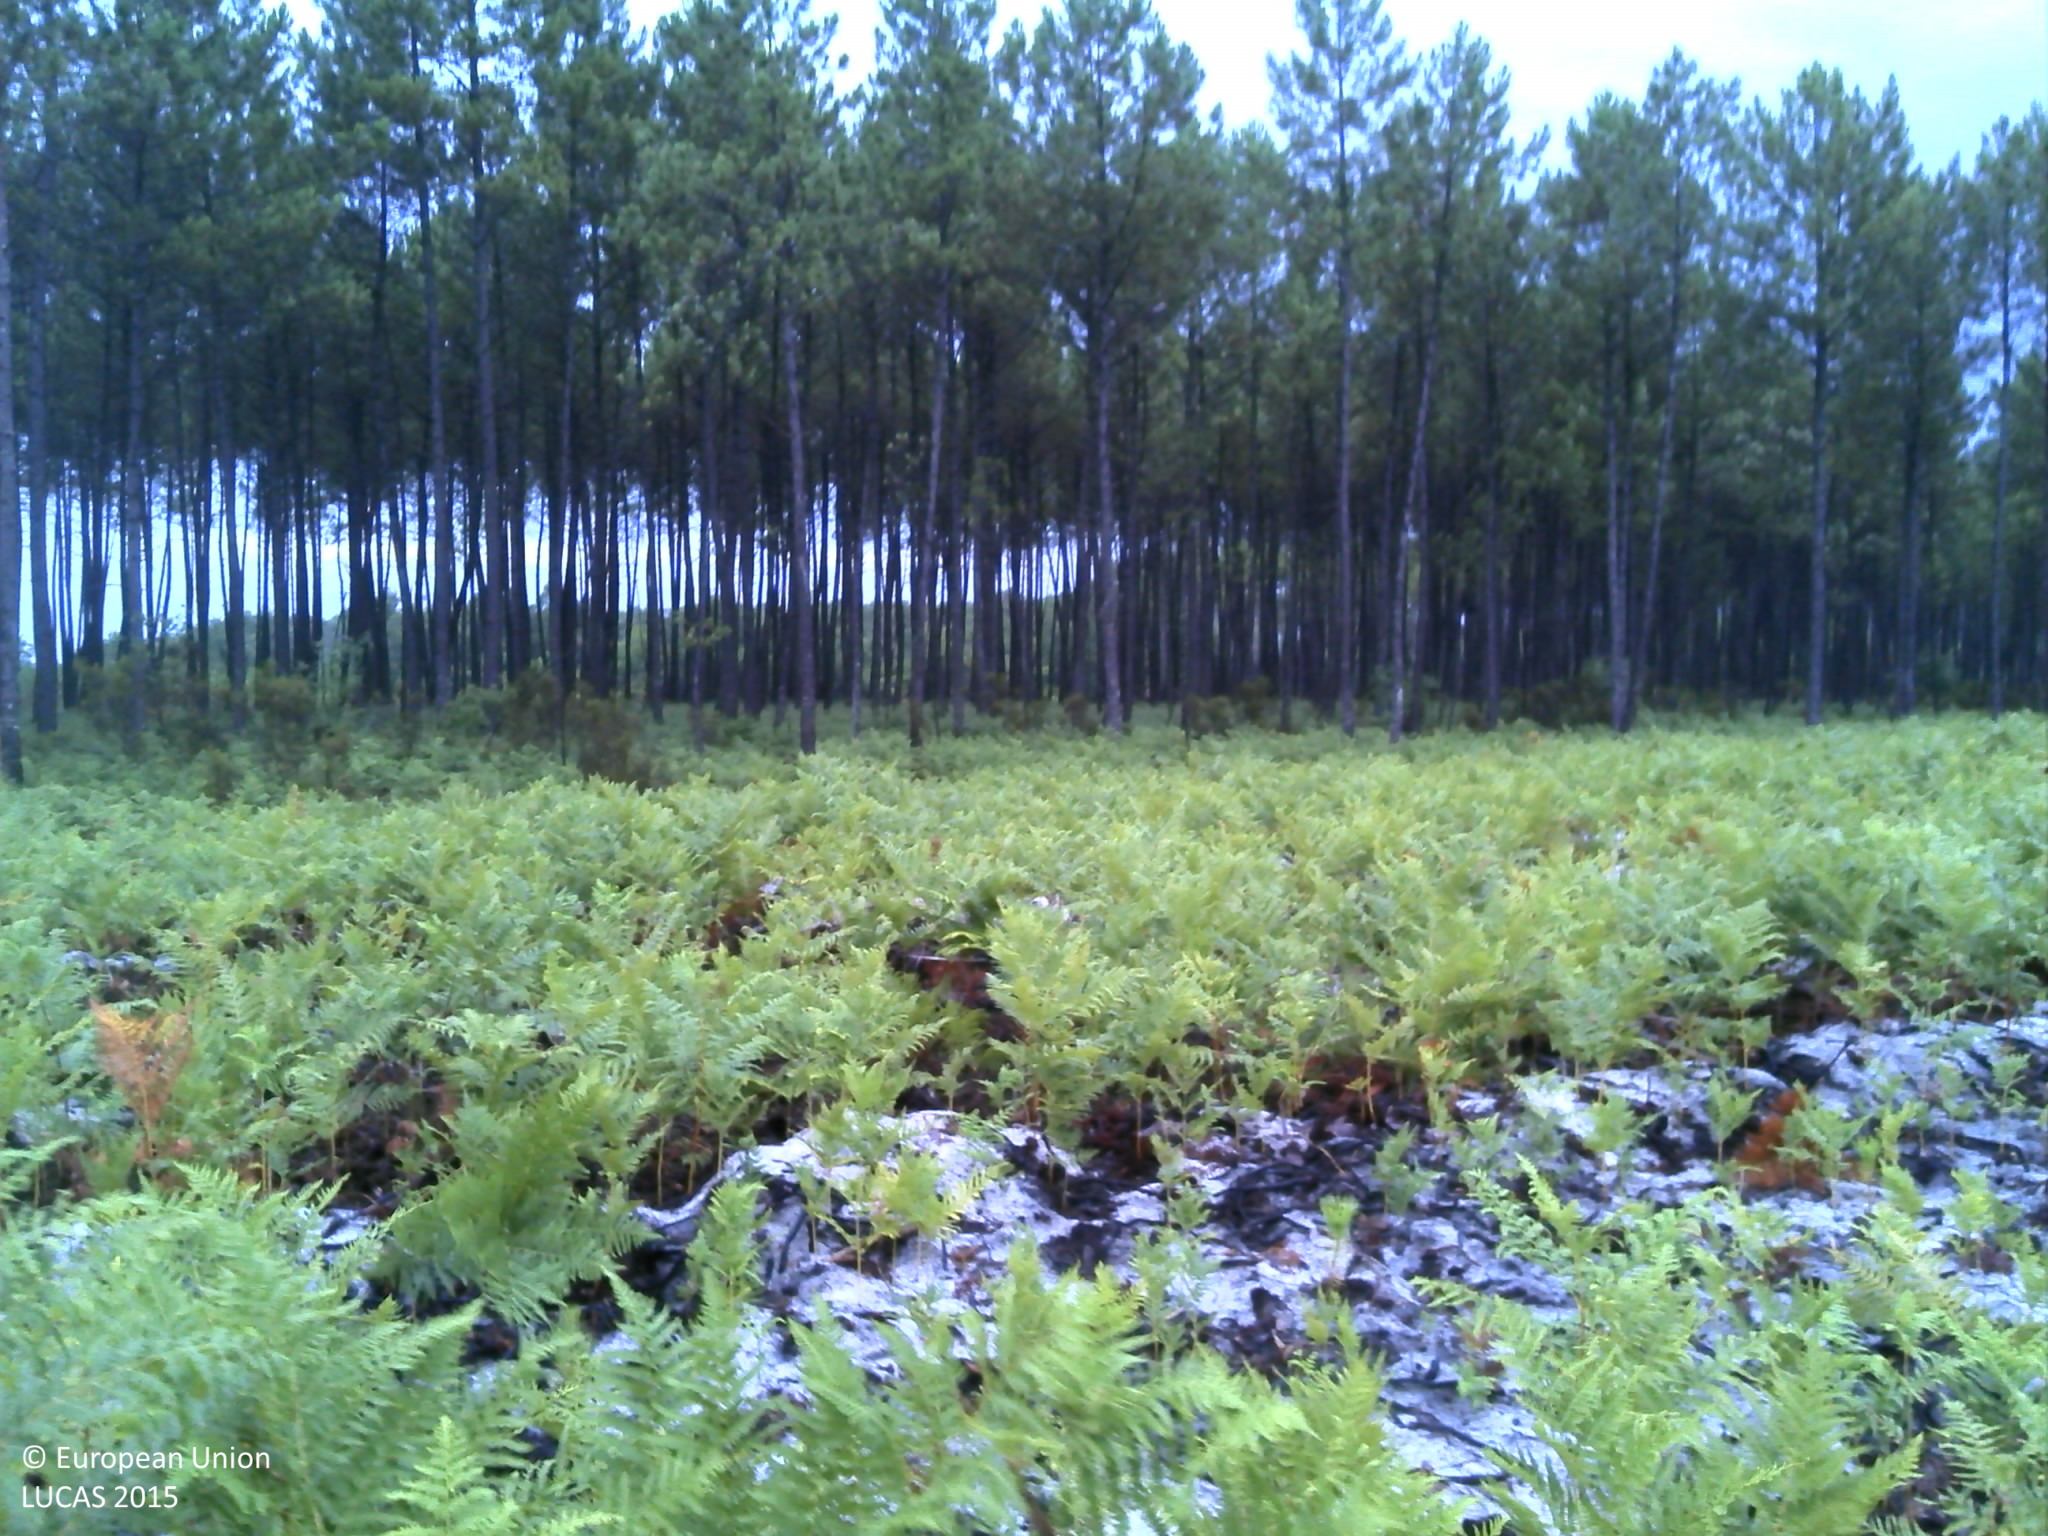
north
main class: Grassland
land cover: Spontaneously vegetated surfaces
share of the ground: > 75 %
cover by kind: herbaceous plants 90 %, shrubs 5 %, lichens and mosses 5 %
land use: Forestry
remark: Clear cut
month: August
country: FR
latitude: 44.5378
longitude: -0.9060
